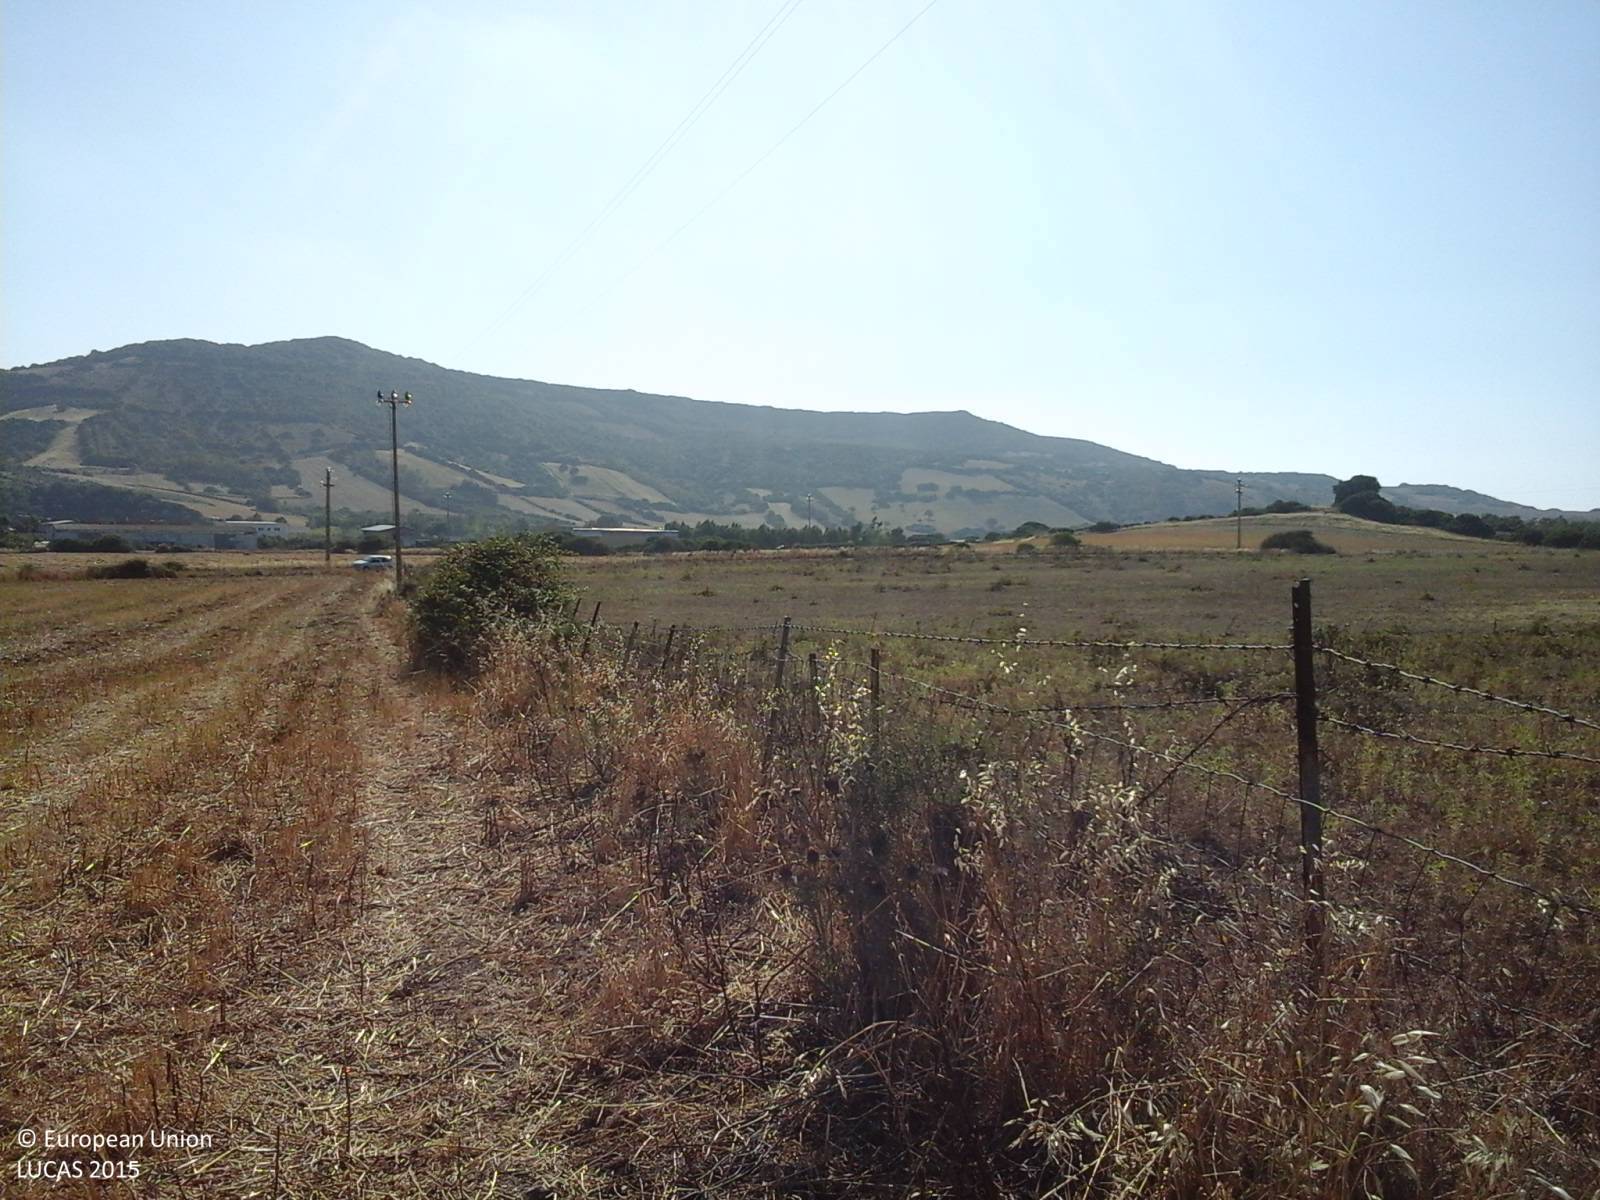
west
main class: Grassland
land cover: Grassland without tree/shrub cover
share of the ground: > 75 %
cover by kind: herbaceous plants 100 %
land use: Agriculture (excluding fallow land and kitchen gardens)
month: June
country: IT
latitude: 39.8976
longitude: 8.7787
